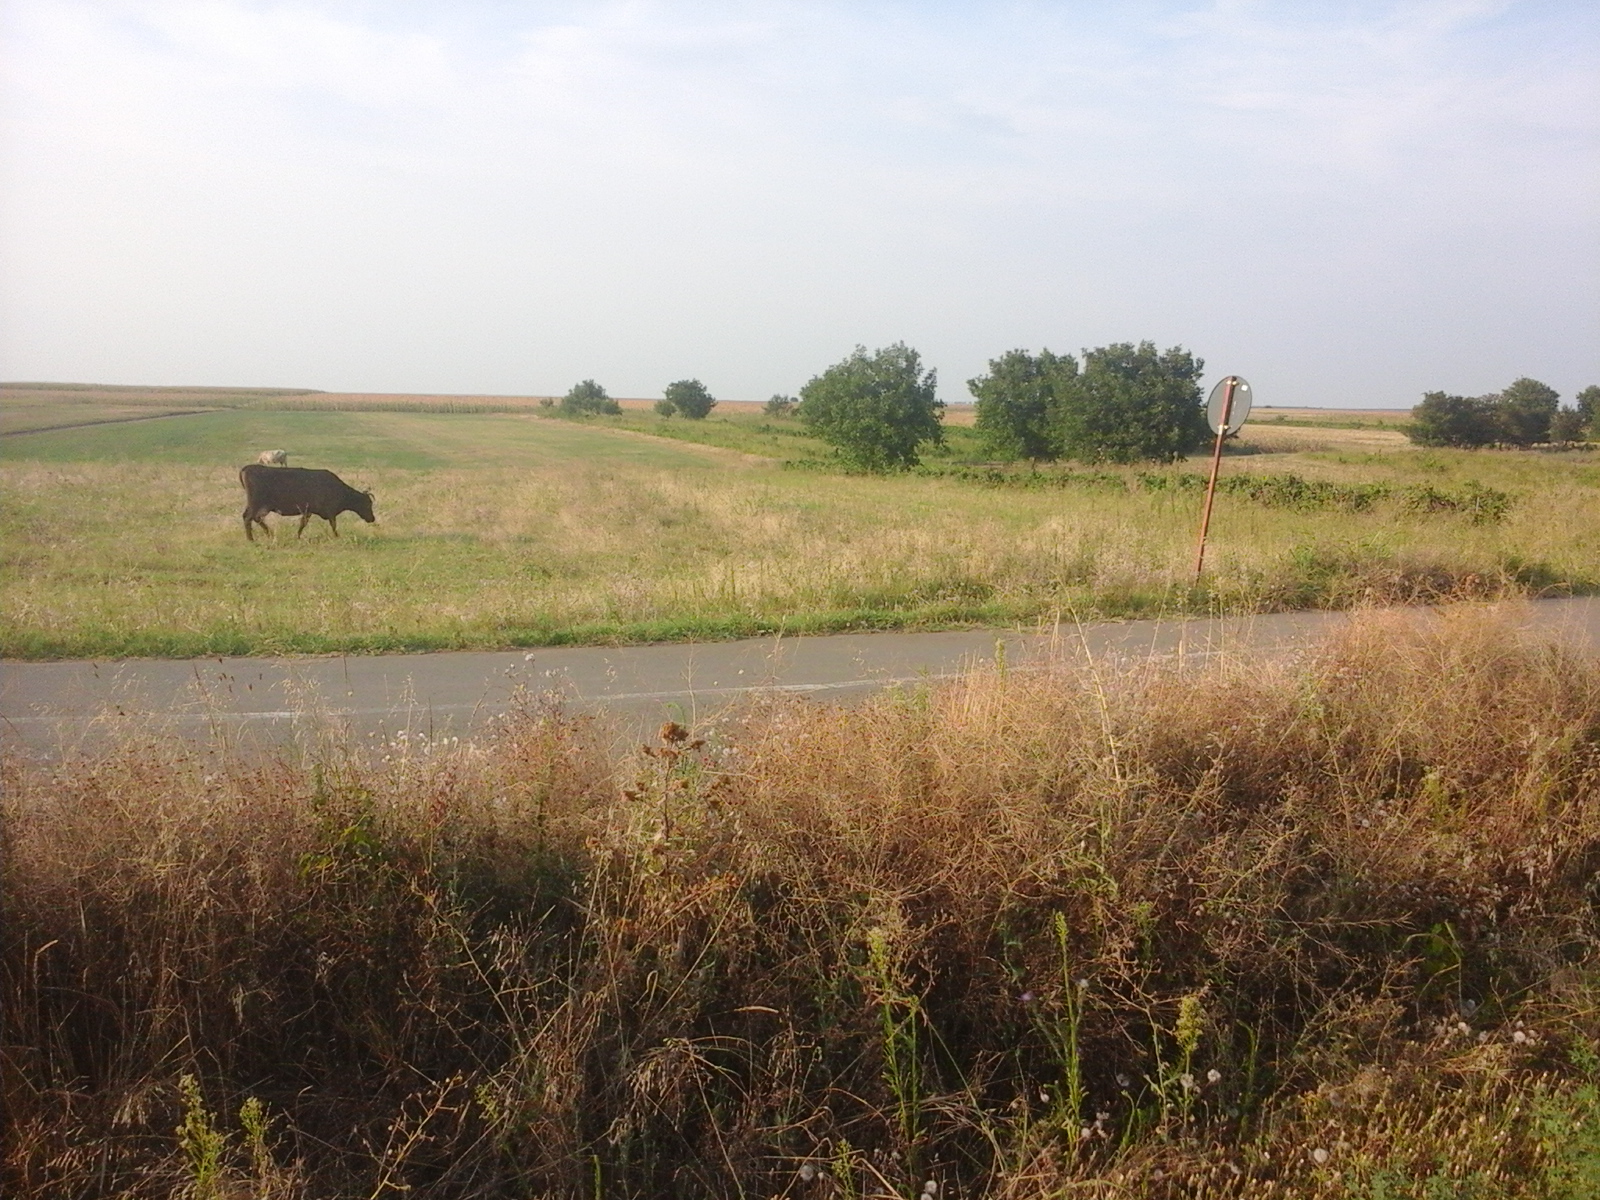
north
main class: Cropland
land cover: Lucerne
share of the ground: > 75 %
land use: Agriculture (excluding fallow land and kitchen gardens)
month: August
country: RO
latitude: 44.1444
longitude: 23.4636
